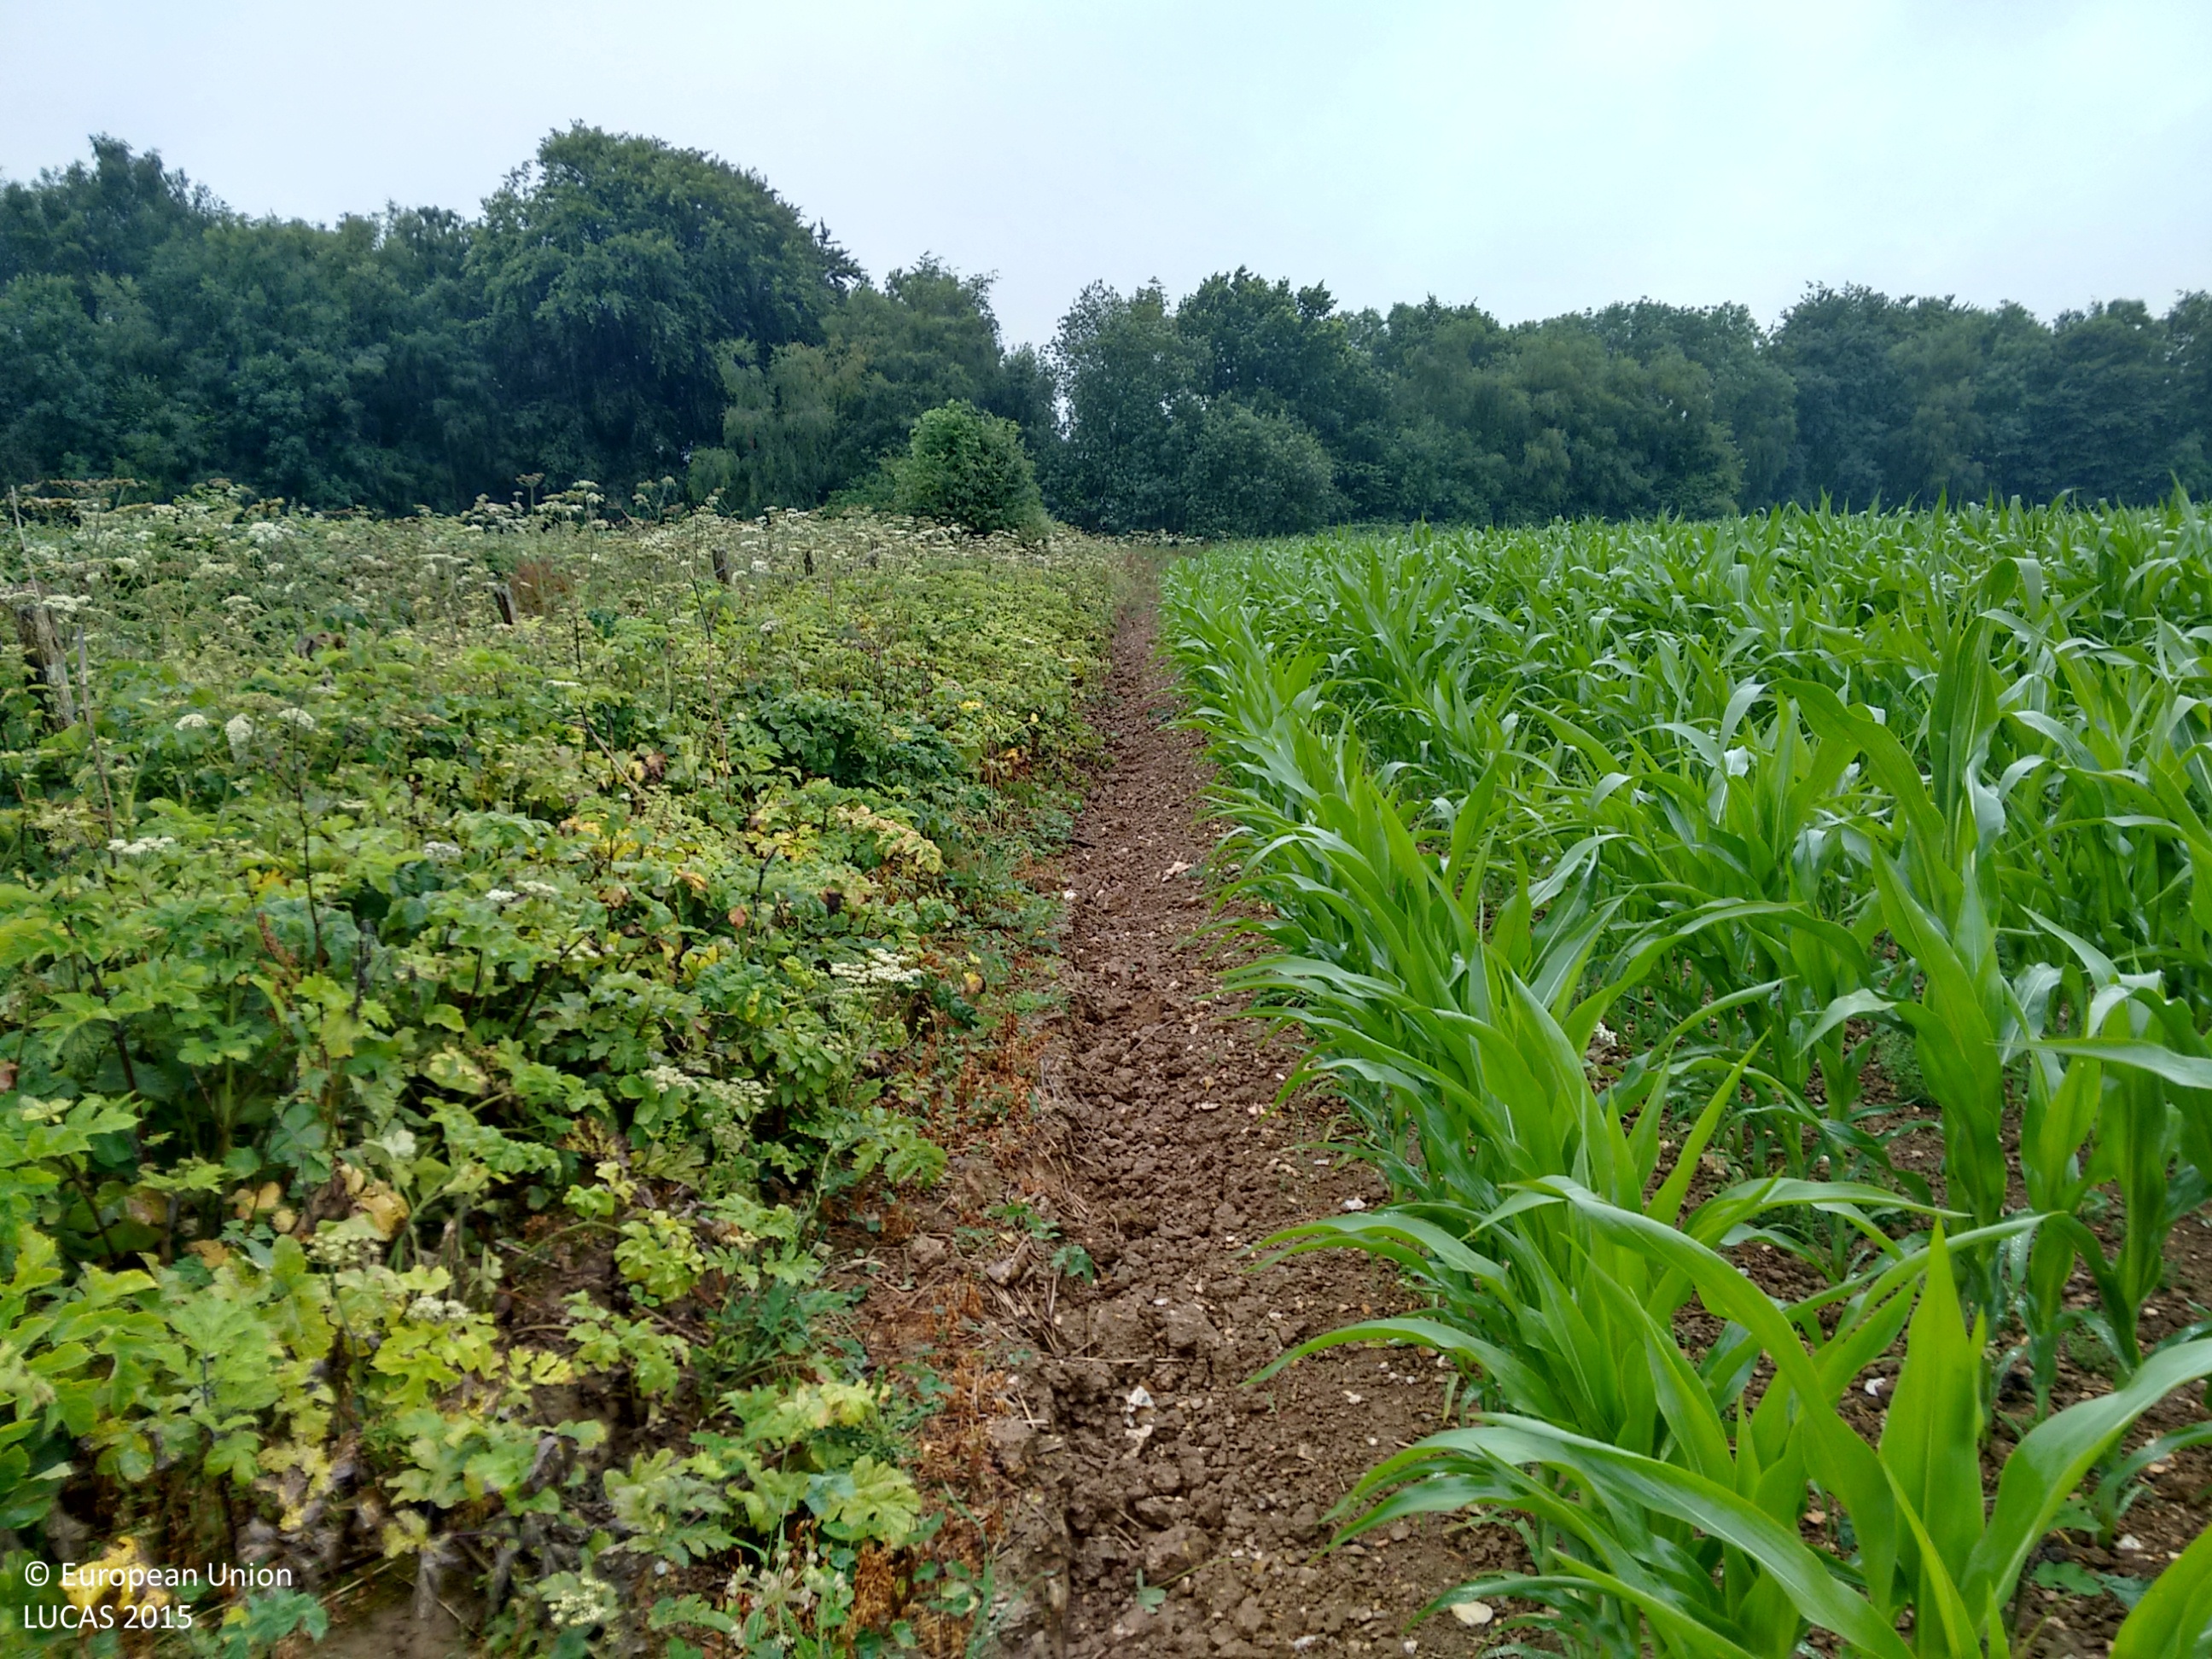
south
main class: Cropland
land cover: Maize
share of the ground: 50 - 75 %
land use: Agriculture (excluding fallow land and kitchen gardens)
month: July
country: GB
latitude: 51.1912
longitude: -1.0195
